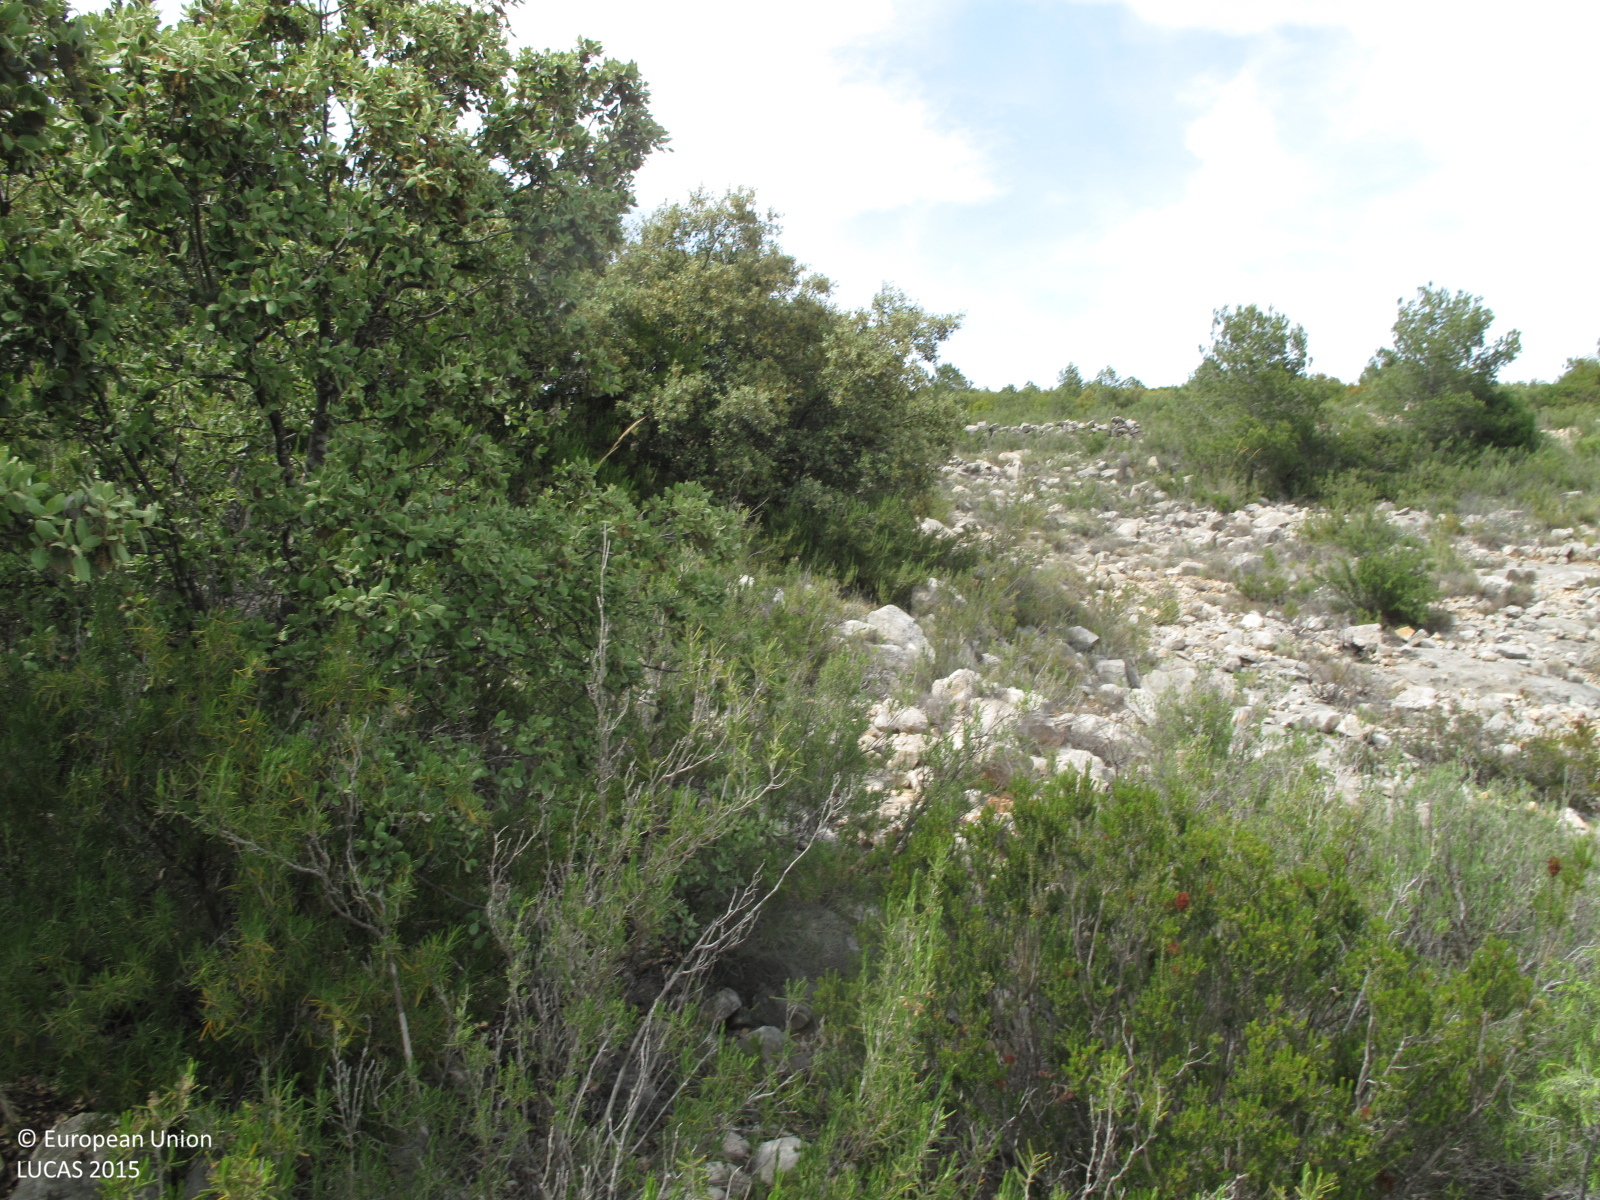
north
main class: Shrubland
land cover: Shrubland with sparse tree cover
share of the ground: 25 - 50 %
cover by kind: consolidated bare surface 50 %, shrubs 25 %, herbaceous plants 20 %, broadleaved forest trees 5 %
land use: Semi-natural and natural areas not in use
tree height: < 5 m
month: May
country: ES
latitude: 38.8212
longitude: -0.7147
